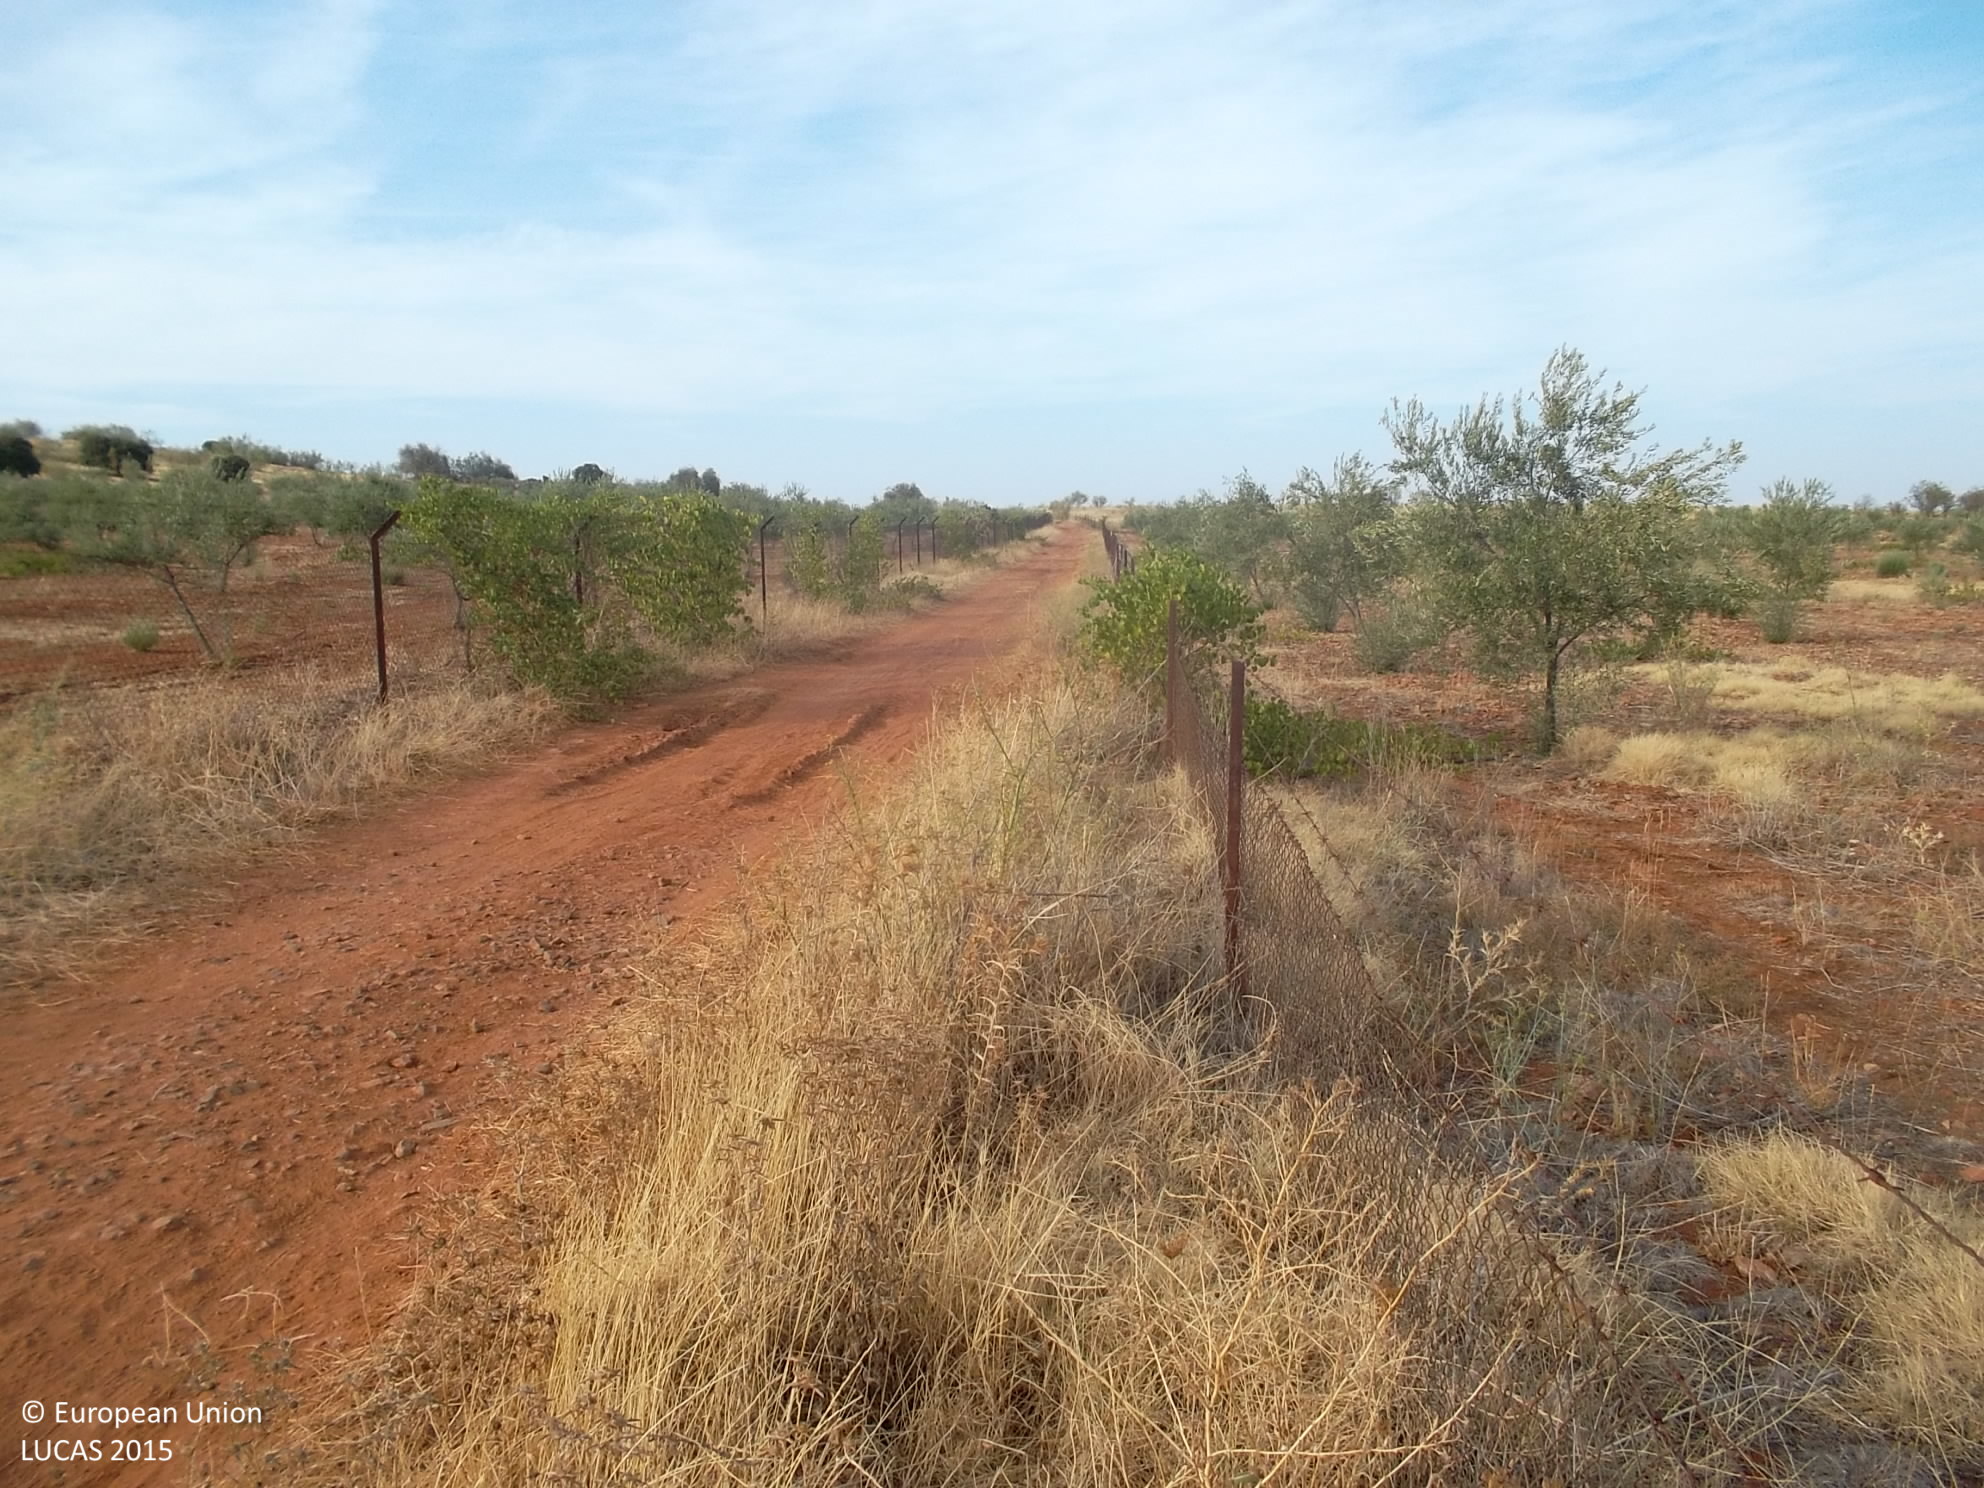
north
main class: Cropland
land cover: Olive groves
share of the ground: 10 - 25 %
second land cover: Grassland without tree/shrub cover
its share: > 75 %
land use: Agriculture (excluding fallow land and kitchen gardens)
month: September
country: ES
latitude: 38.4955
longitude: -6.3663
